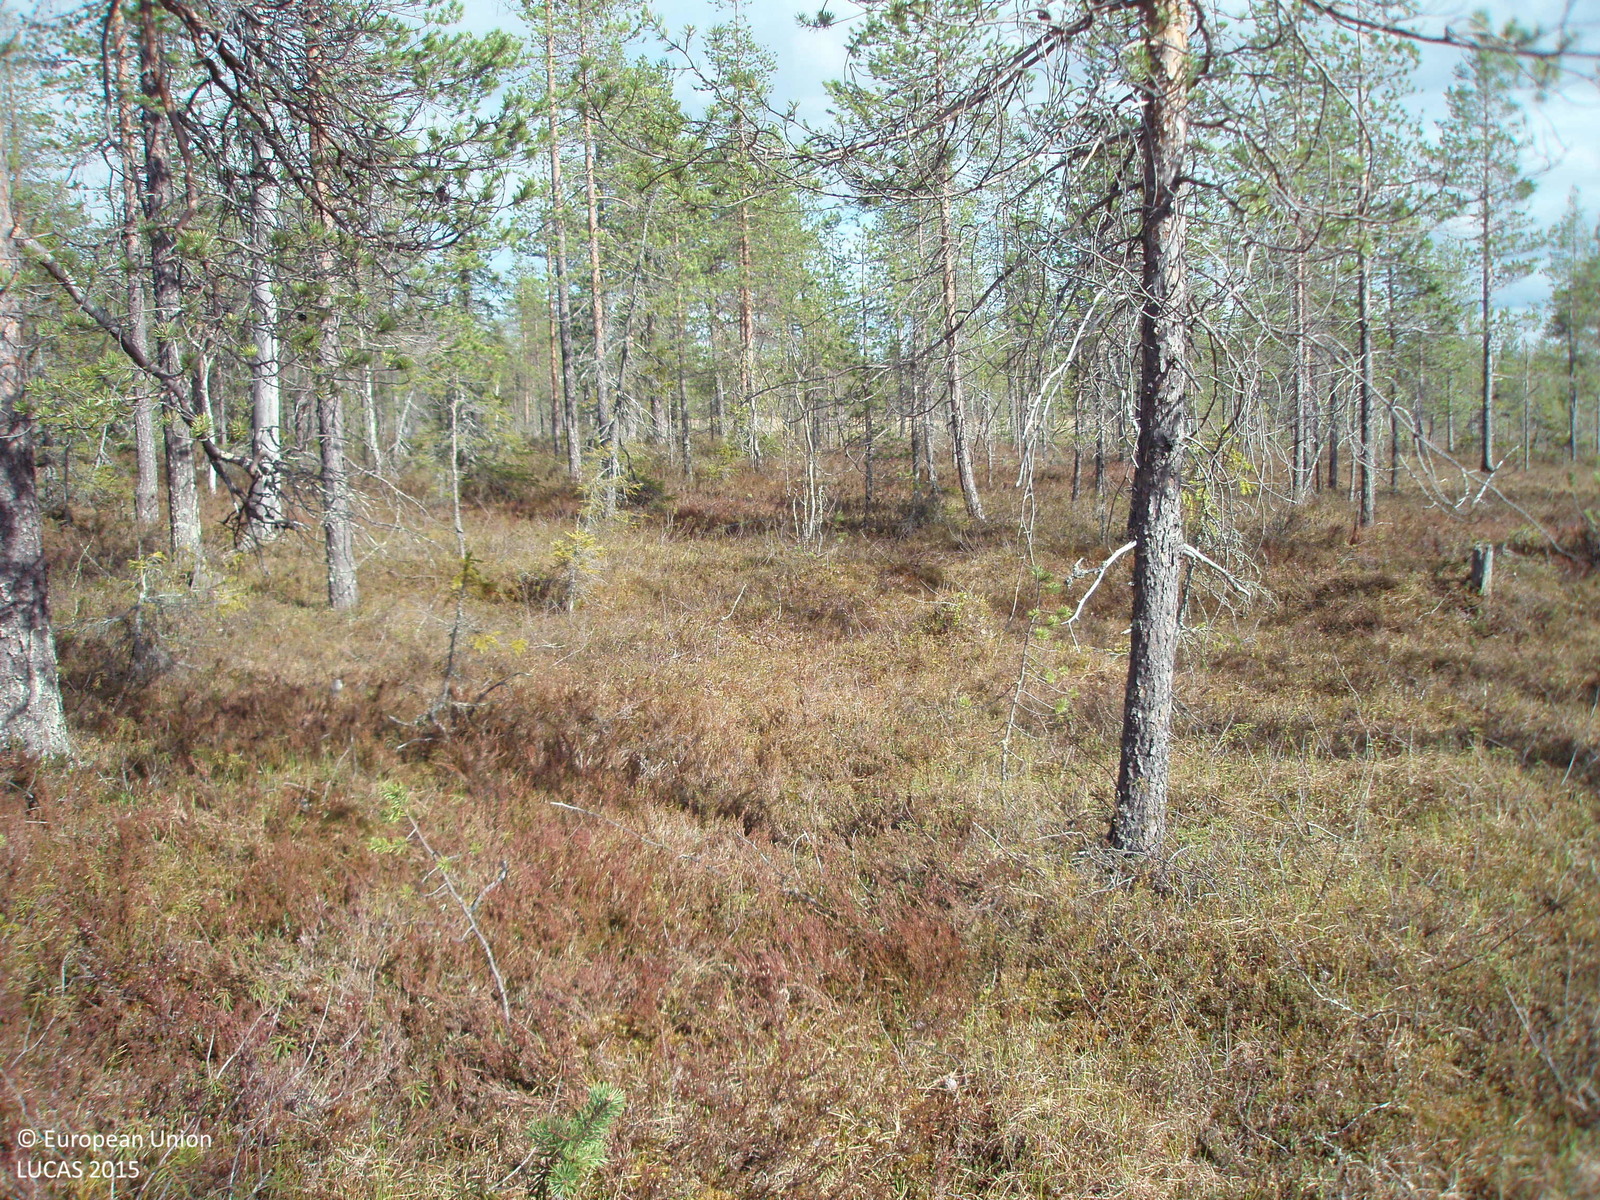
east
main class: Woodland
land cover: Pine dominated coniferous woodland
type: mire and swamp forests
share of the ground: 50 - 75 %
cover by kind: coniferous forest trees 50 %, shrubs 25 %, herbaceous plants 20 %, broadleaved forest trees 5 %
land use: Forestry
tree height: > 5 m
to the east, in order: Pine dominated coniferous woodland; Pine dominated mixed woodland; Pine dominated coniferous woodland
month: June
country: FI
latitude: 66.7227
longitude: 26.8507
